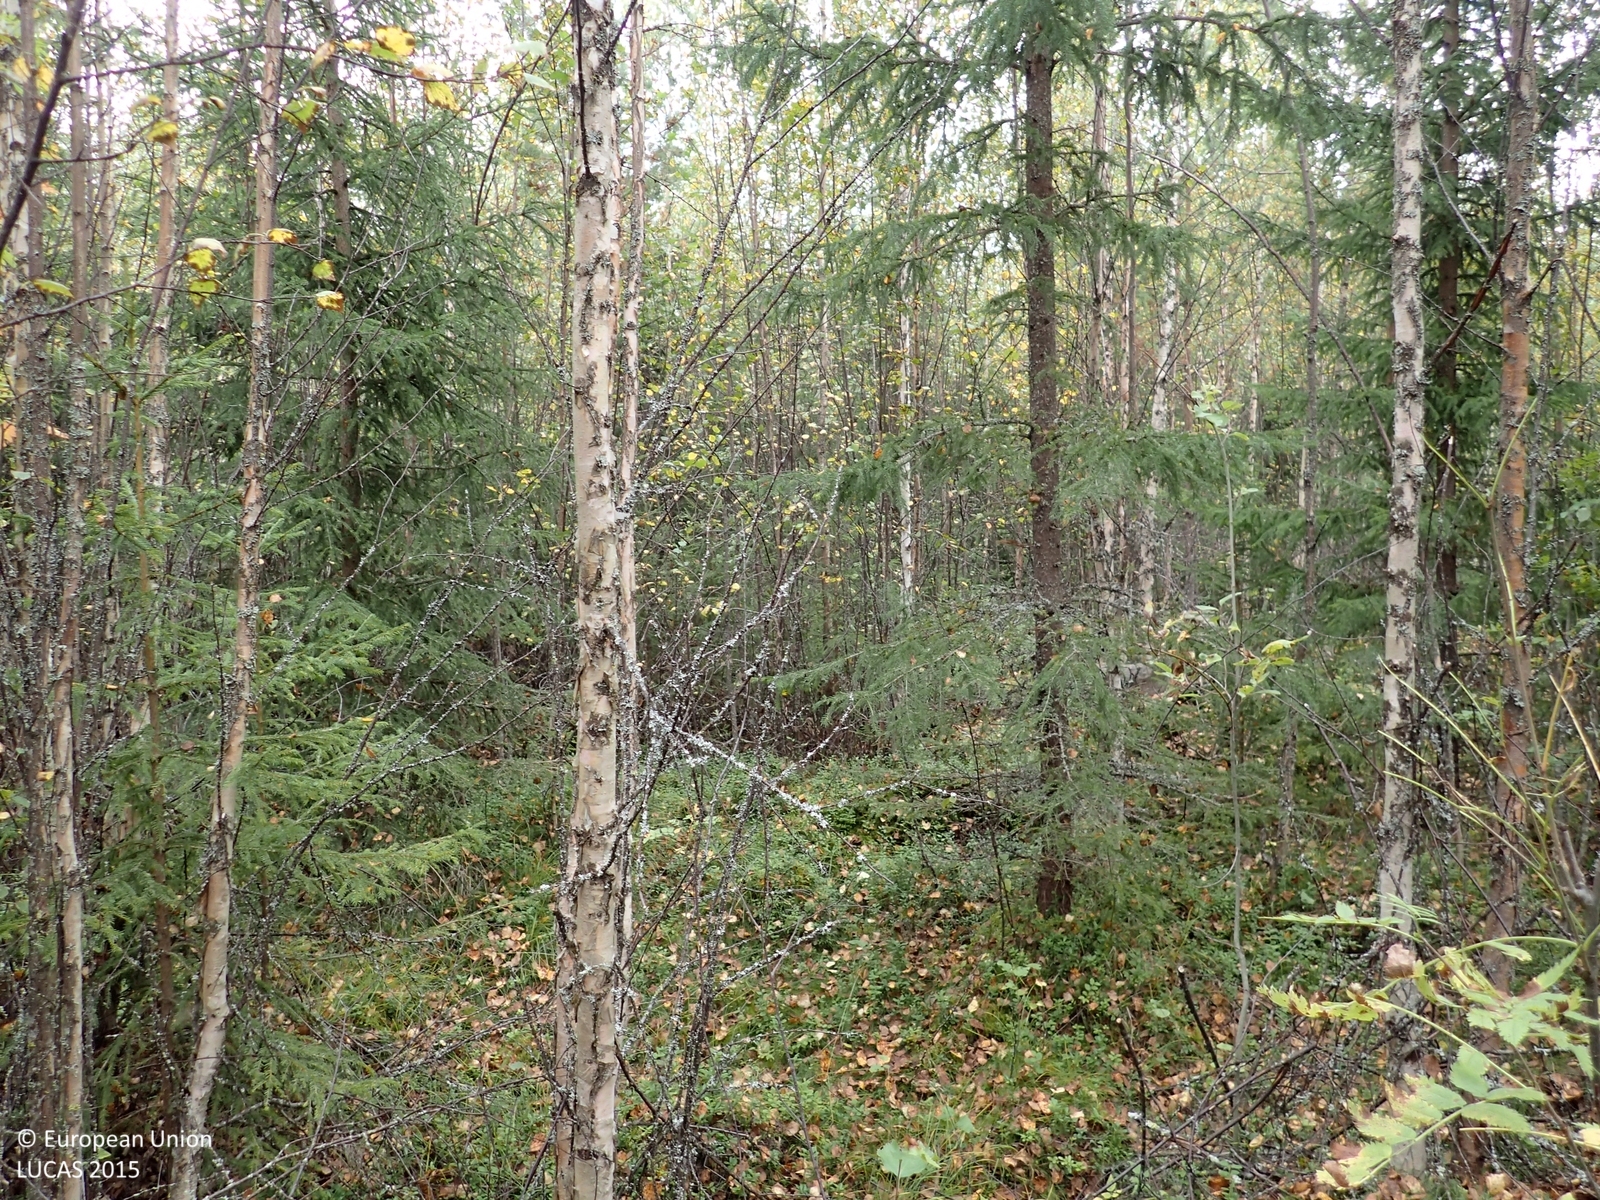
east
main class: Woodland
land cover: Spruce dominated mixed woodland
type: boreal forest
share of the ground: > 75 %
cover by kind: broadleaved forest trees 50 %, coniferous forest trees 35 %, shrubs 5 %, herbaceous plants 5 %, lichens and mosses 5 %
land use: Forestry
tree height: < 5 m
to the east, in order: Spruce dominated mixed woodland; Ditches and canals; Spruce dominated mixed woodland; Ditches and canals; Spruce dominated mixed woodland; Ditches and canals; Spruce dominated mixed woodland; Ditches and canals; Spruce dominated mixed woodland; Broadleaved woodland; Ditches and canals; Pine dominated mixed woodland
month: September
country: FI
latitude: 62.9199
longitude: 25.9289
